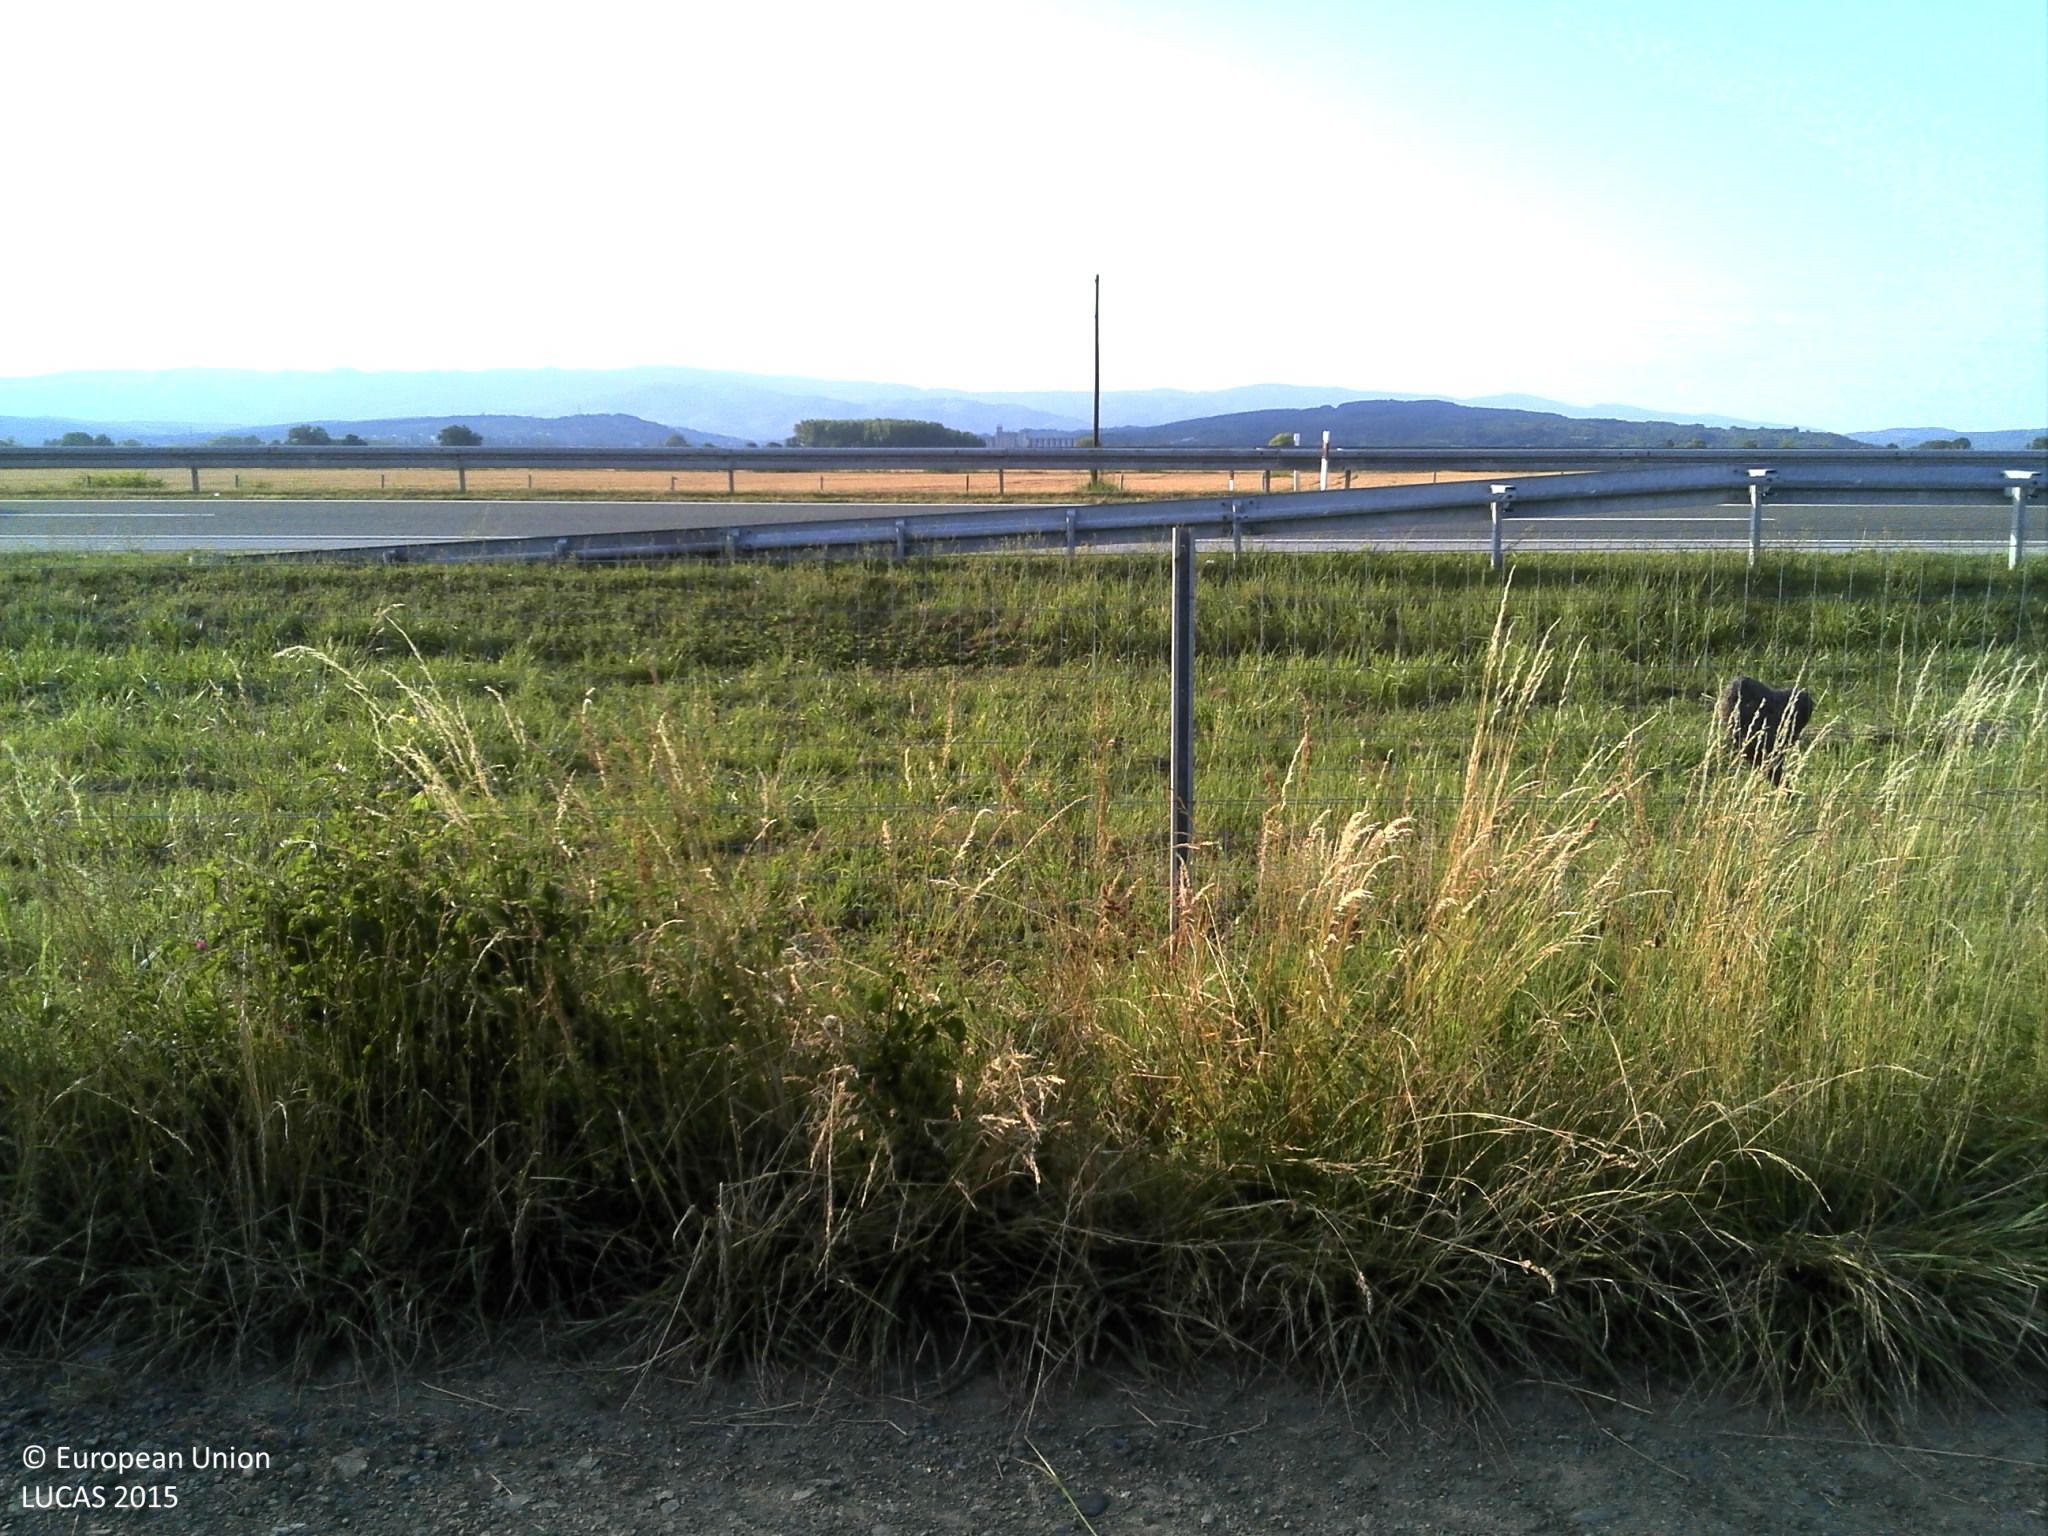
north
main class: Grassland
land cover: Spontaneously vegetated surfaces
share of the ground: > 75 %
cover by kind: herbaceous plants 100 %
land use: Fallow land
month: June
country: HR
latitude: 45.2264
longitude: 17.3998
